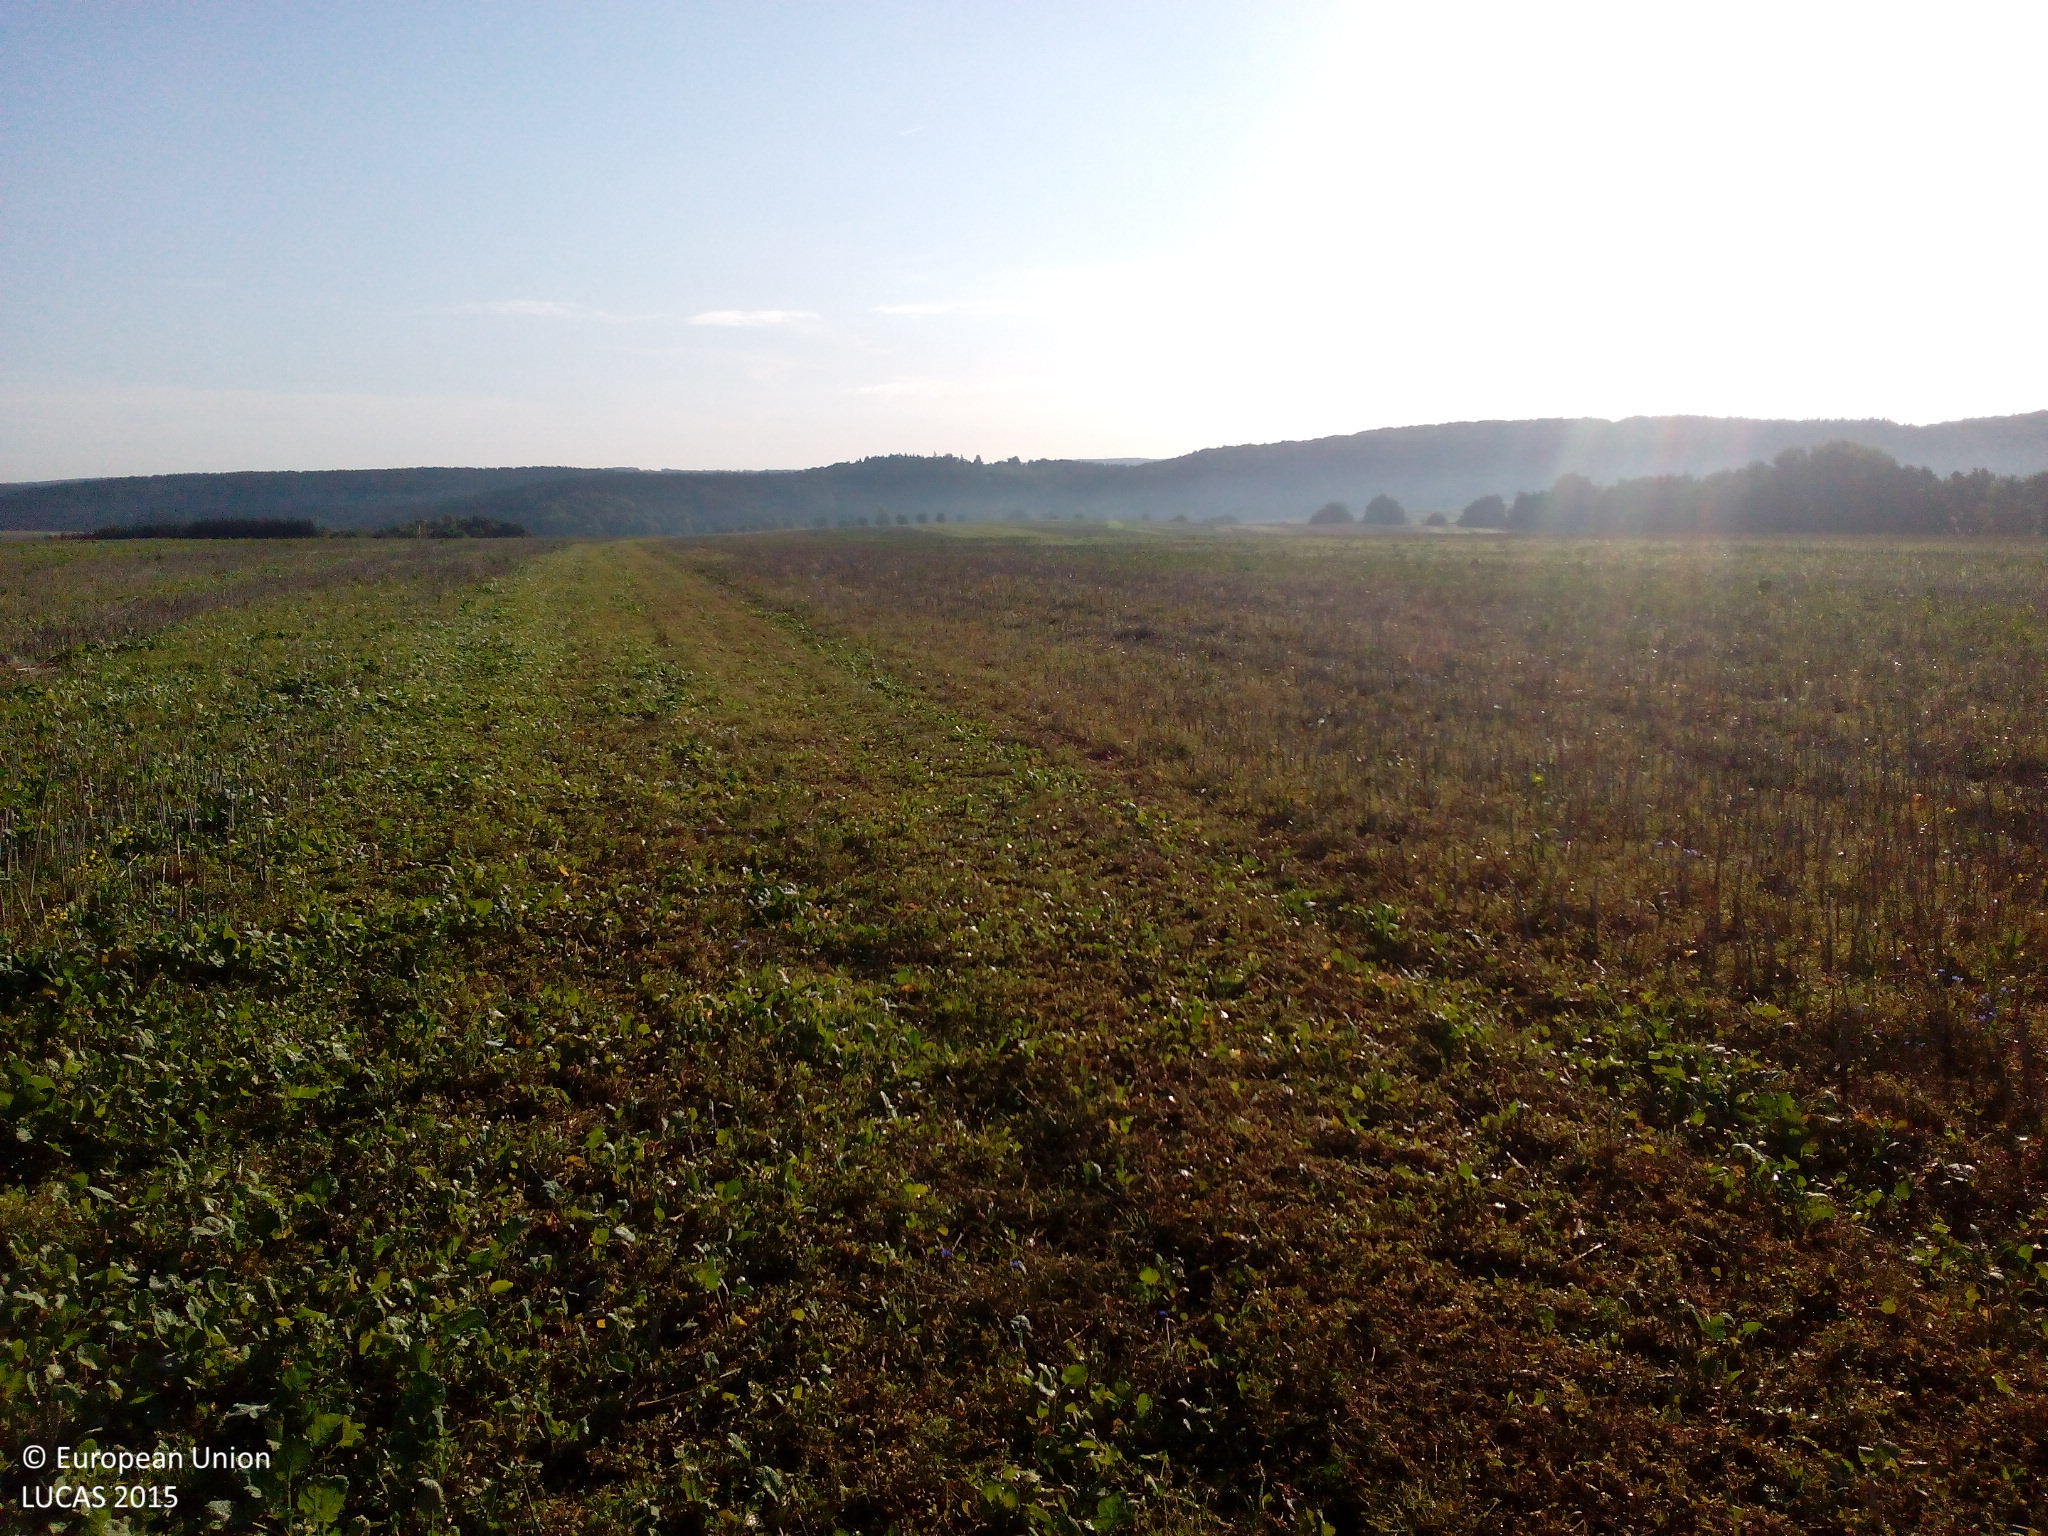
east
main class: Cropland
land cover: Rape and turnip rape
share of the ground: > 75 %
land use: Agriculture (excluding fallow land and kitchen gardens)
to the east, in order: Rape and turnip rape
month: September
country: DE
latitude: 51.5456
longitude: 11.0812
